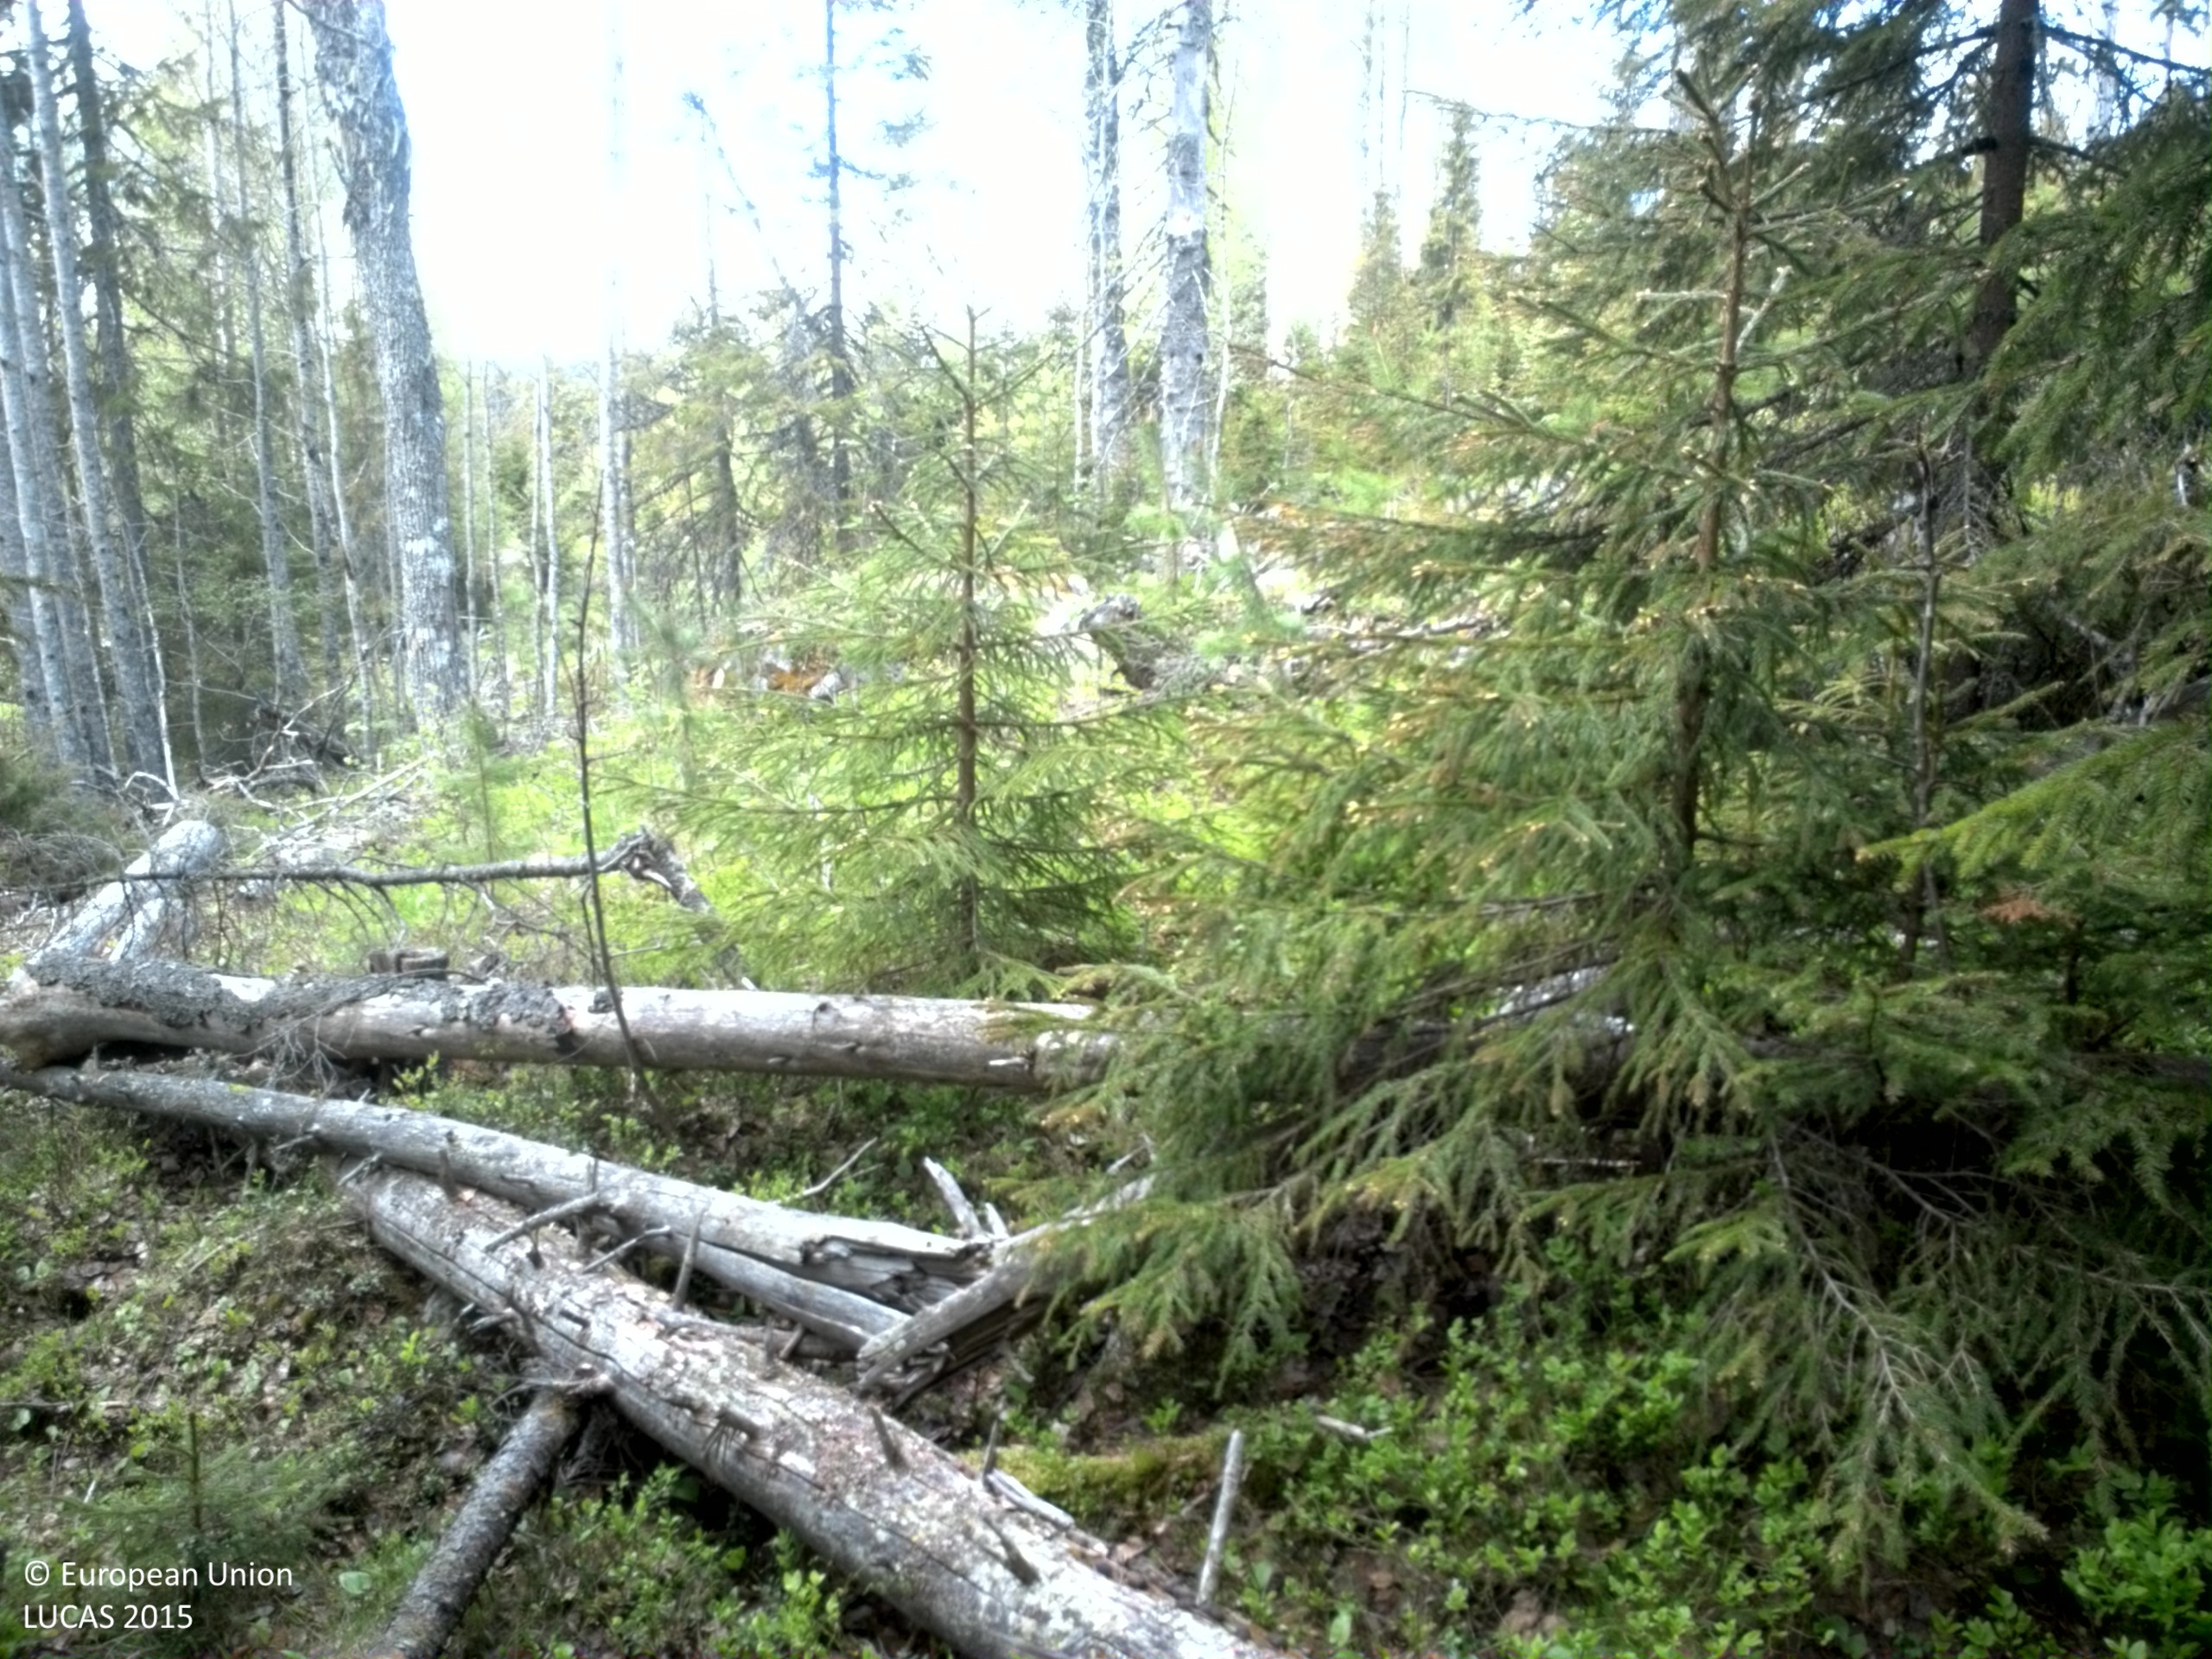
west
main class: Woodland
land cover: Spruce dominated coniferous woodland
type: boreal forest
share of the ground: > 75 %
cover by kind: coniferous forest trees 80 %, shrubs 15 %, herbaceous plants 5 %
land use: Forestry
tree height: > 5 m
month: June
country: SE
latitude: 62.9592
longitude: 17.3313
